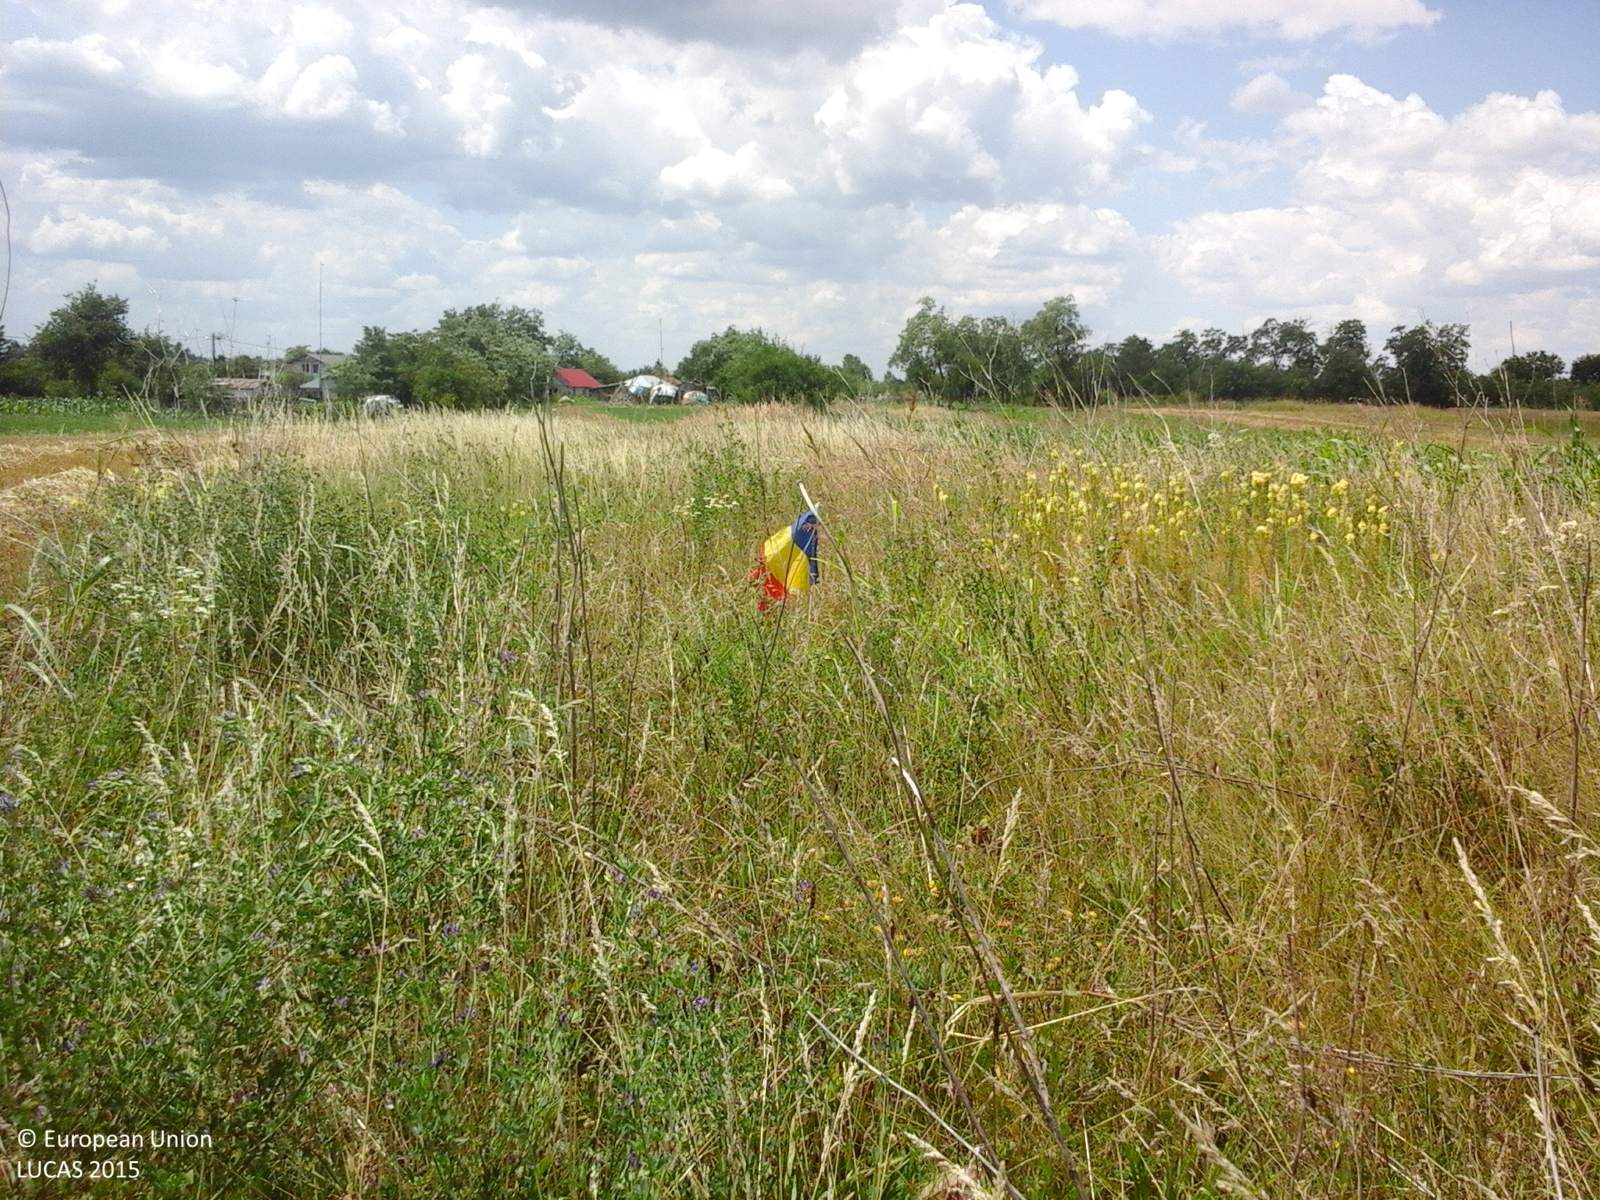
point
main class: Grassland
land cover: Spontaneously vegetated surfaces
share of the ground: > 75 %
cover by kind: herbaceous plants 100 %
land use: Fallow land
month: July
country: RO
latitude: 44.2906
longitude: 25.4148
